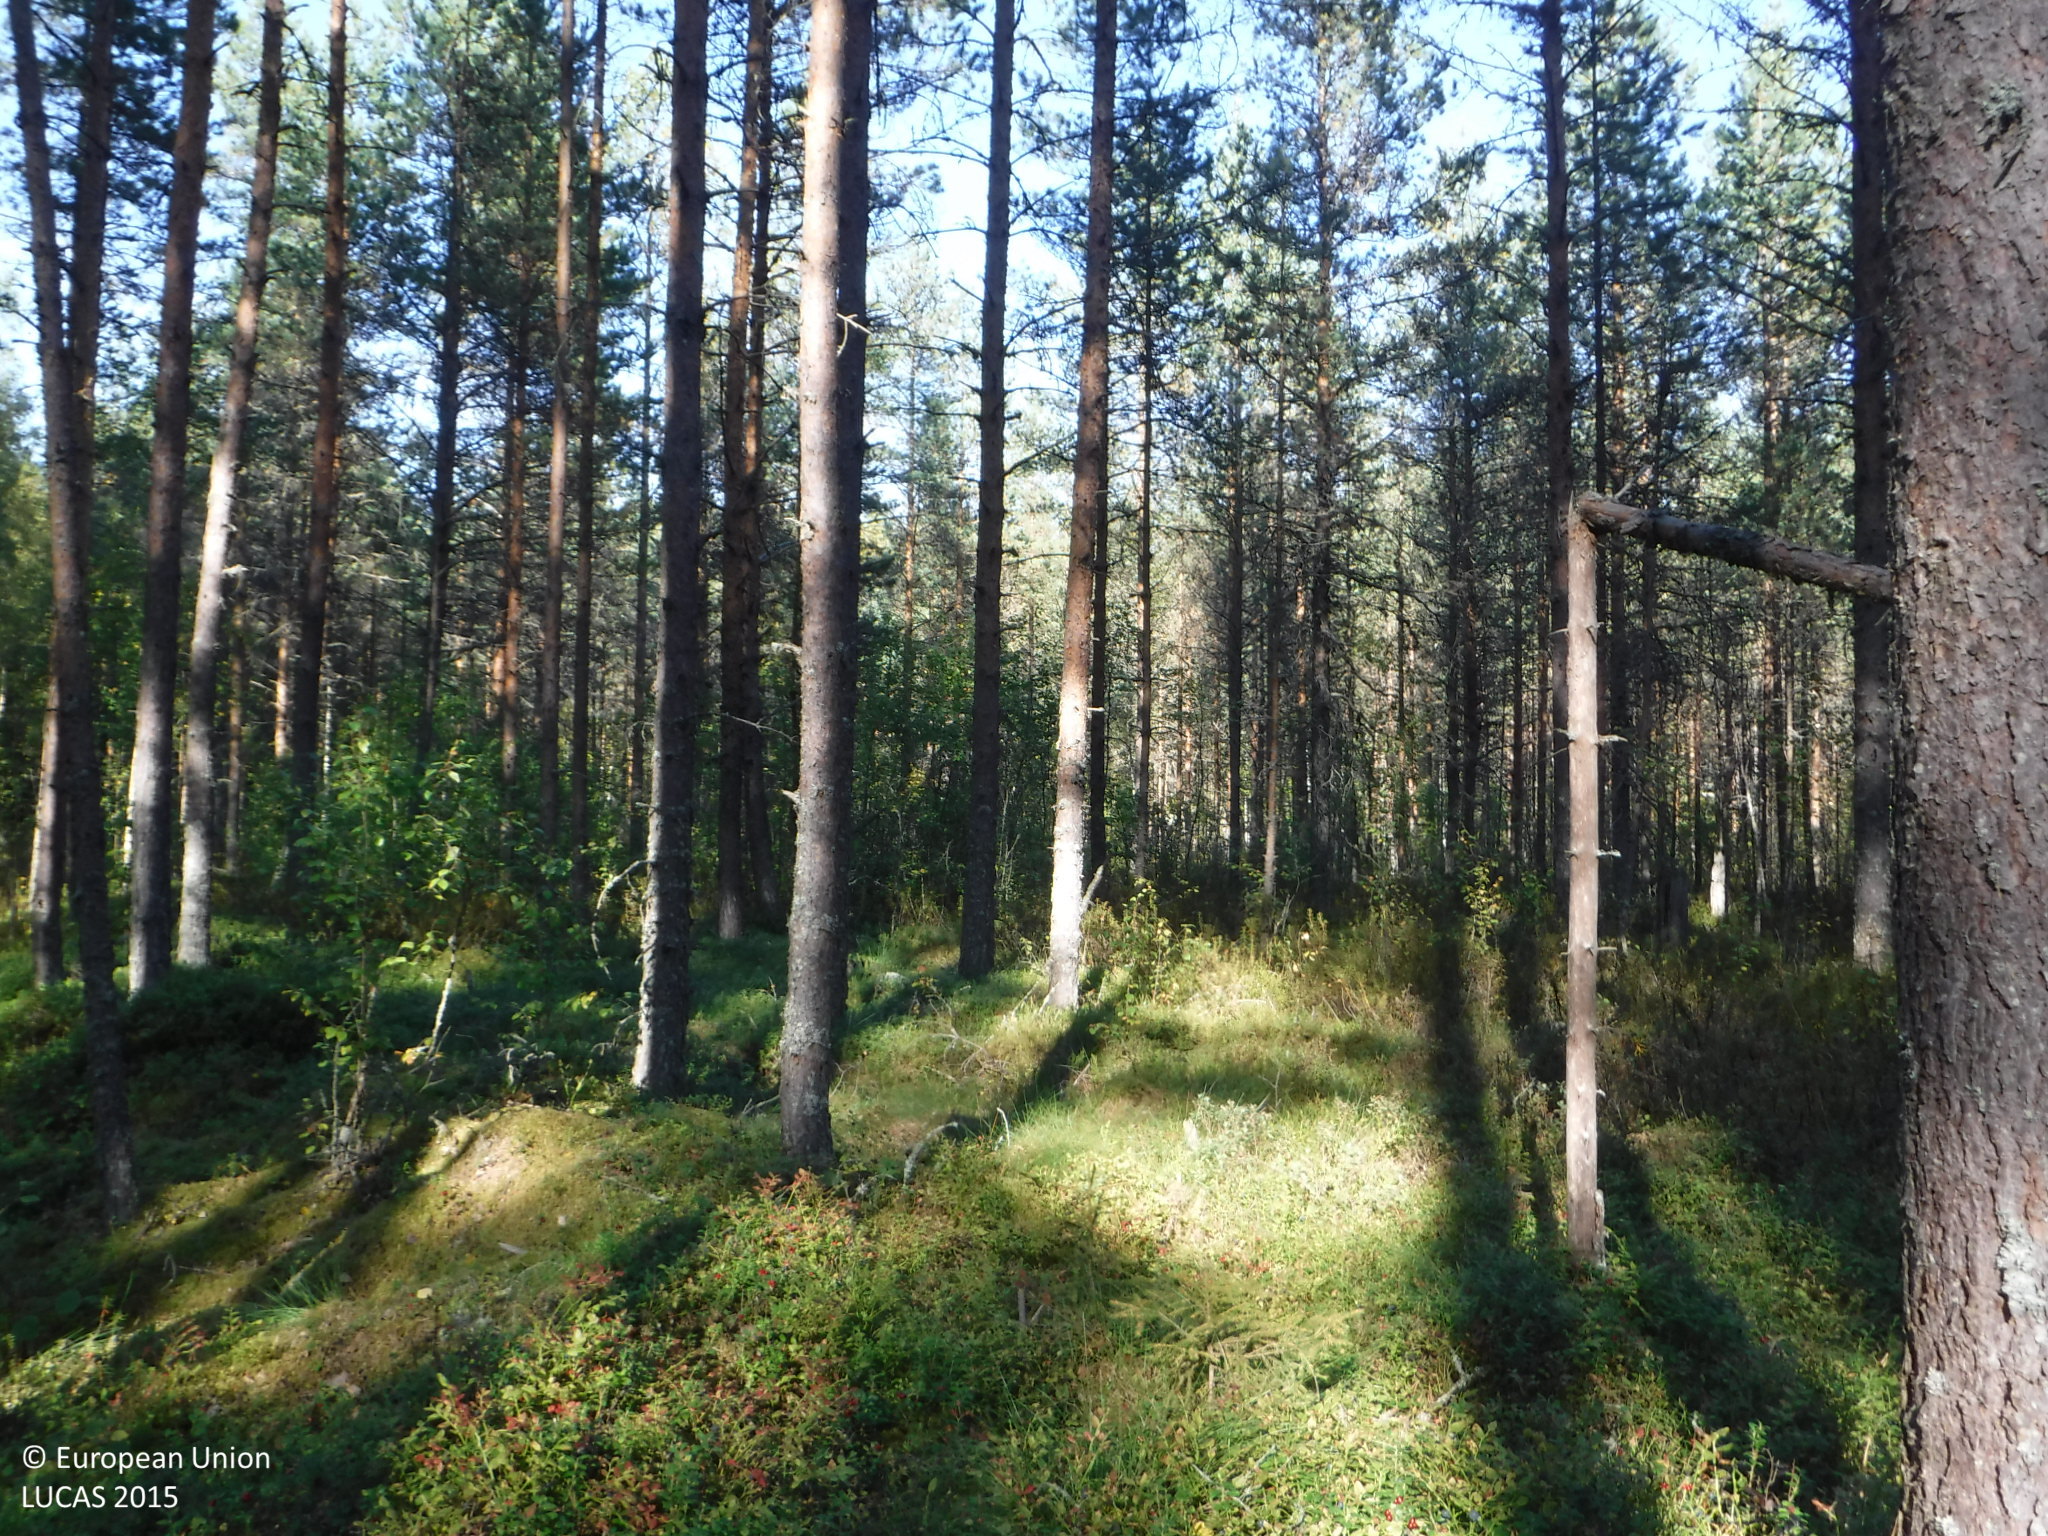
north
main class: Woodland
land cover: Pine dominated coniferous woodland
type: boreal forest
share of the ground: 25 - 50 %
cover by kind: shrubs 50 %, coniferous forest trees 30 %, lichens and mosses 15 %, broadleaved forest trees 5 %
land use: Forestry
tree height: > 5 m
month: September
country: FI
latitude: 61.7157
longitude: 22.7979
